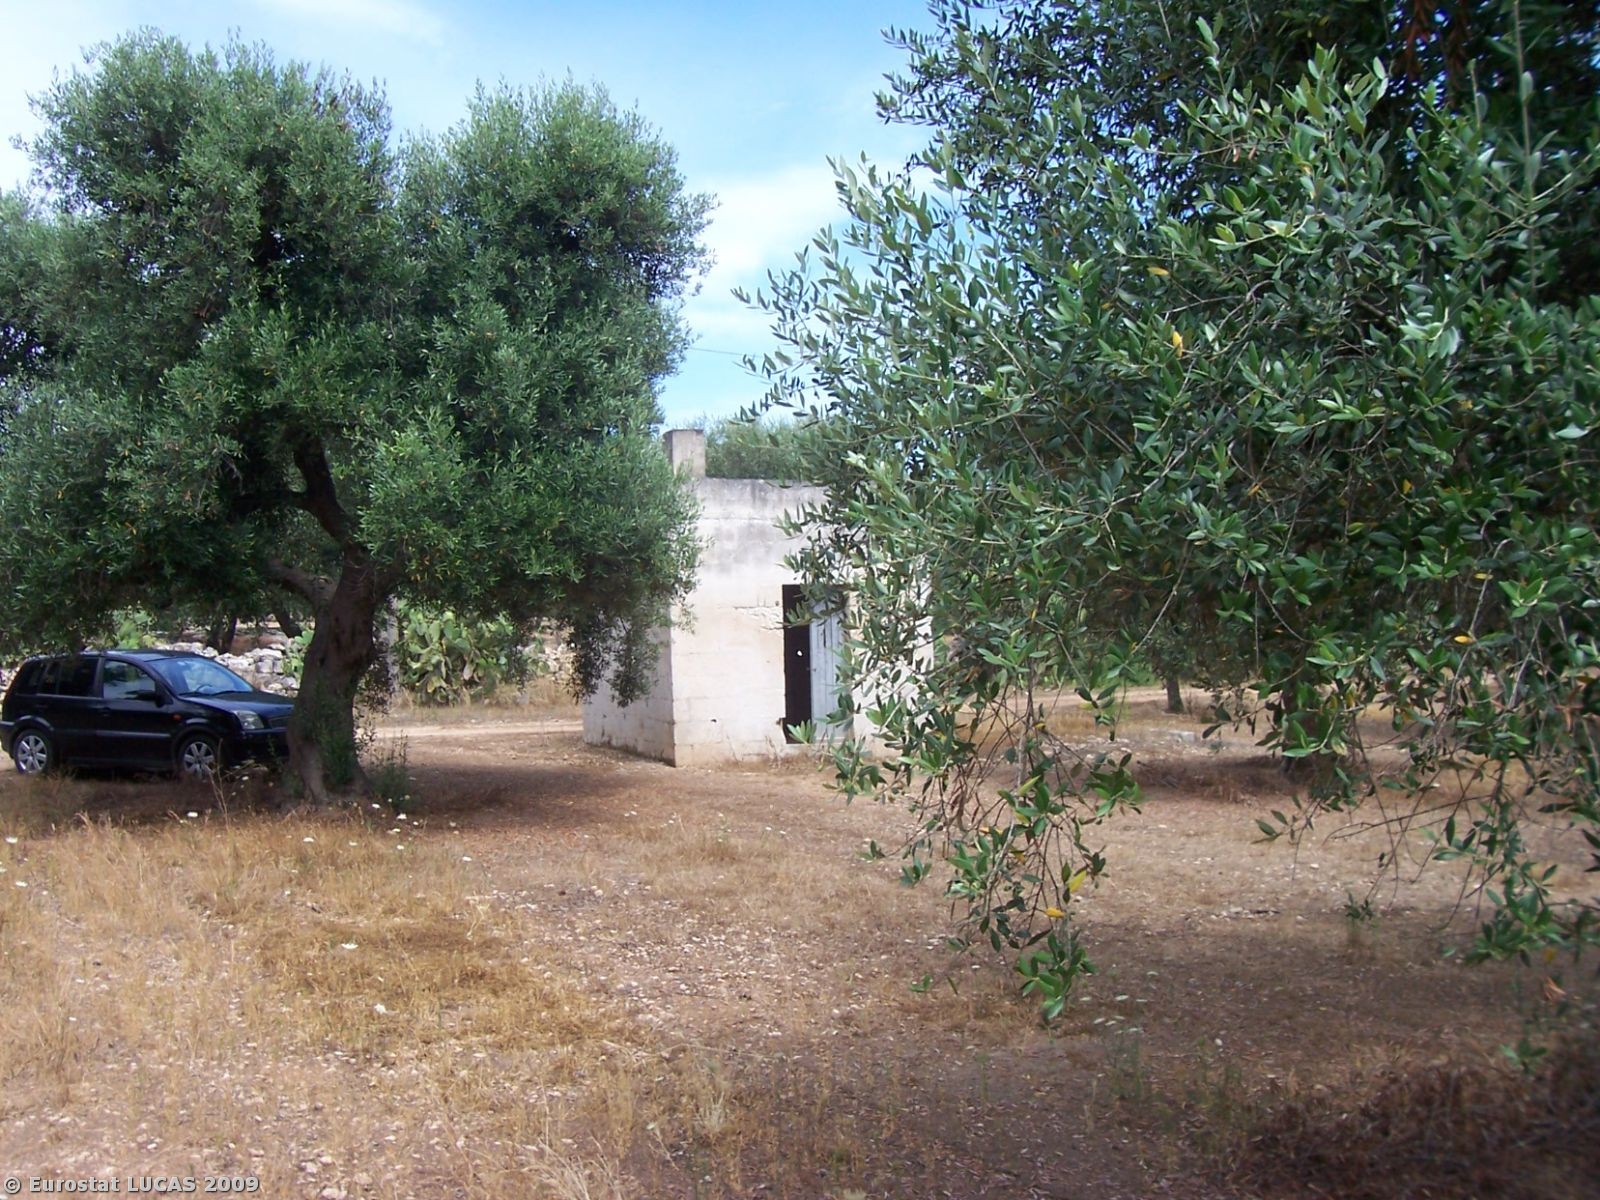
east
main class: Cropland
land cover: Olive groves
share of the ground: 25 - 50 %
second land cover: Bare land
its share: 50 - 75 %
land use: Agriculture (excluding fallow land and kitchen gardens)
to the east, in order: Olive groves; Bare land; Olive groves; Bare land; Artificial constructions in urban areas; Single bushes/trees; Dry stone walls; Olive groves; Bare land; Fences; Olive groves; Bare land; Artificial constructions in urban areas; Olive groves; Bare land; Fences; Paved roads, cycling and walking lanes; Fences; Olive groves; Bare land; Artificial constructions in urban areas; Lines of trees; Fences; Grass margins; Paved roads, cycling and walking lanes; Fences; Olive groves; Bare land; Fences; Tracks; Olive groves; Bare land
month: June
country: IT
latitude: 40.3255
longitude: 17.4952
